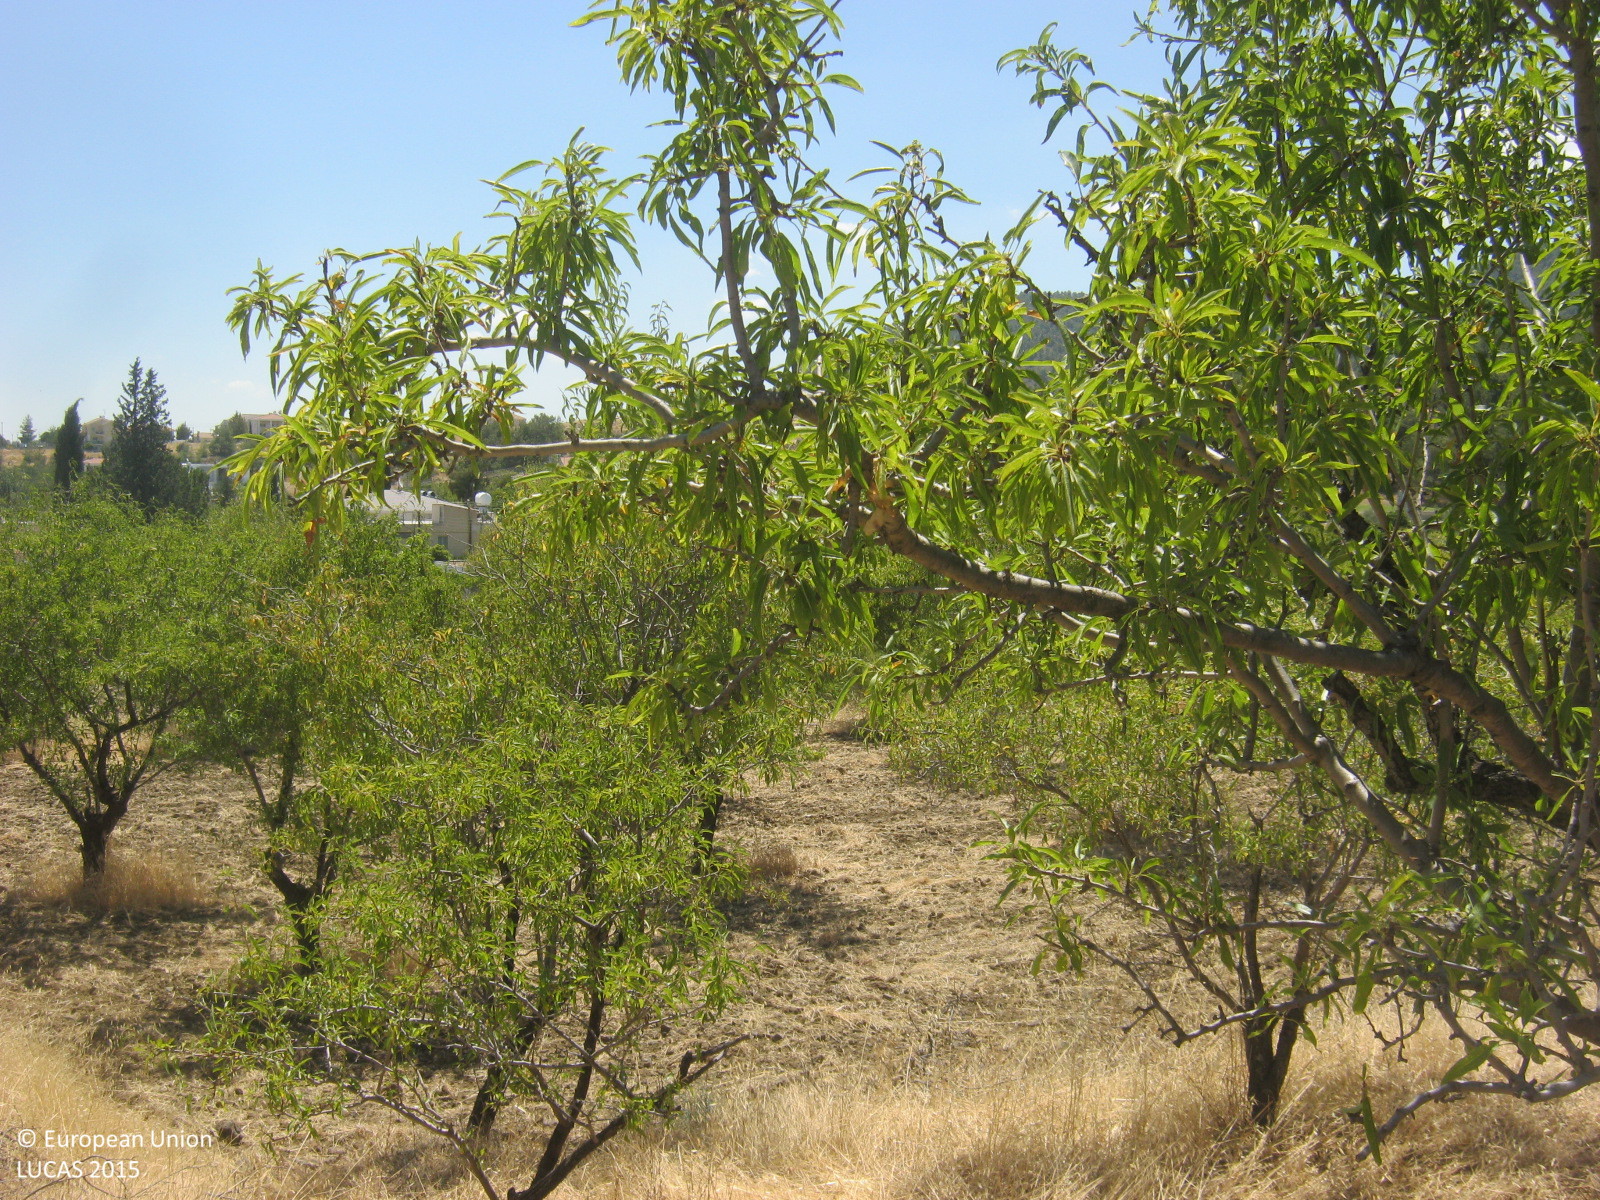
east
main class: Cropland
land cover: Nuts trees
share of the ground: 25 - 50 %
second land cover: Spontaneously vegetated surfaces
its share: 10 - 25 %
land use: Agriculture (excluding fallow land and kitchen gardens)
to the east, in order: Nuts trees; Spontaneously vegetated surfaces; Olive groves; Grass margins; Electric lines; Paved roads, cycling and walking lanes; Grass margins; Grassland with sparse tree/shrub cover; Other bare soil; Artificial constructions in urban areas; Barley
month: June
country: CY
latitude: 35.0152
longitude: 33.1613
